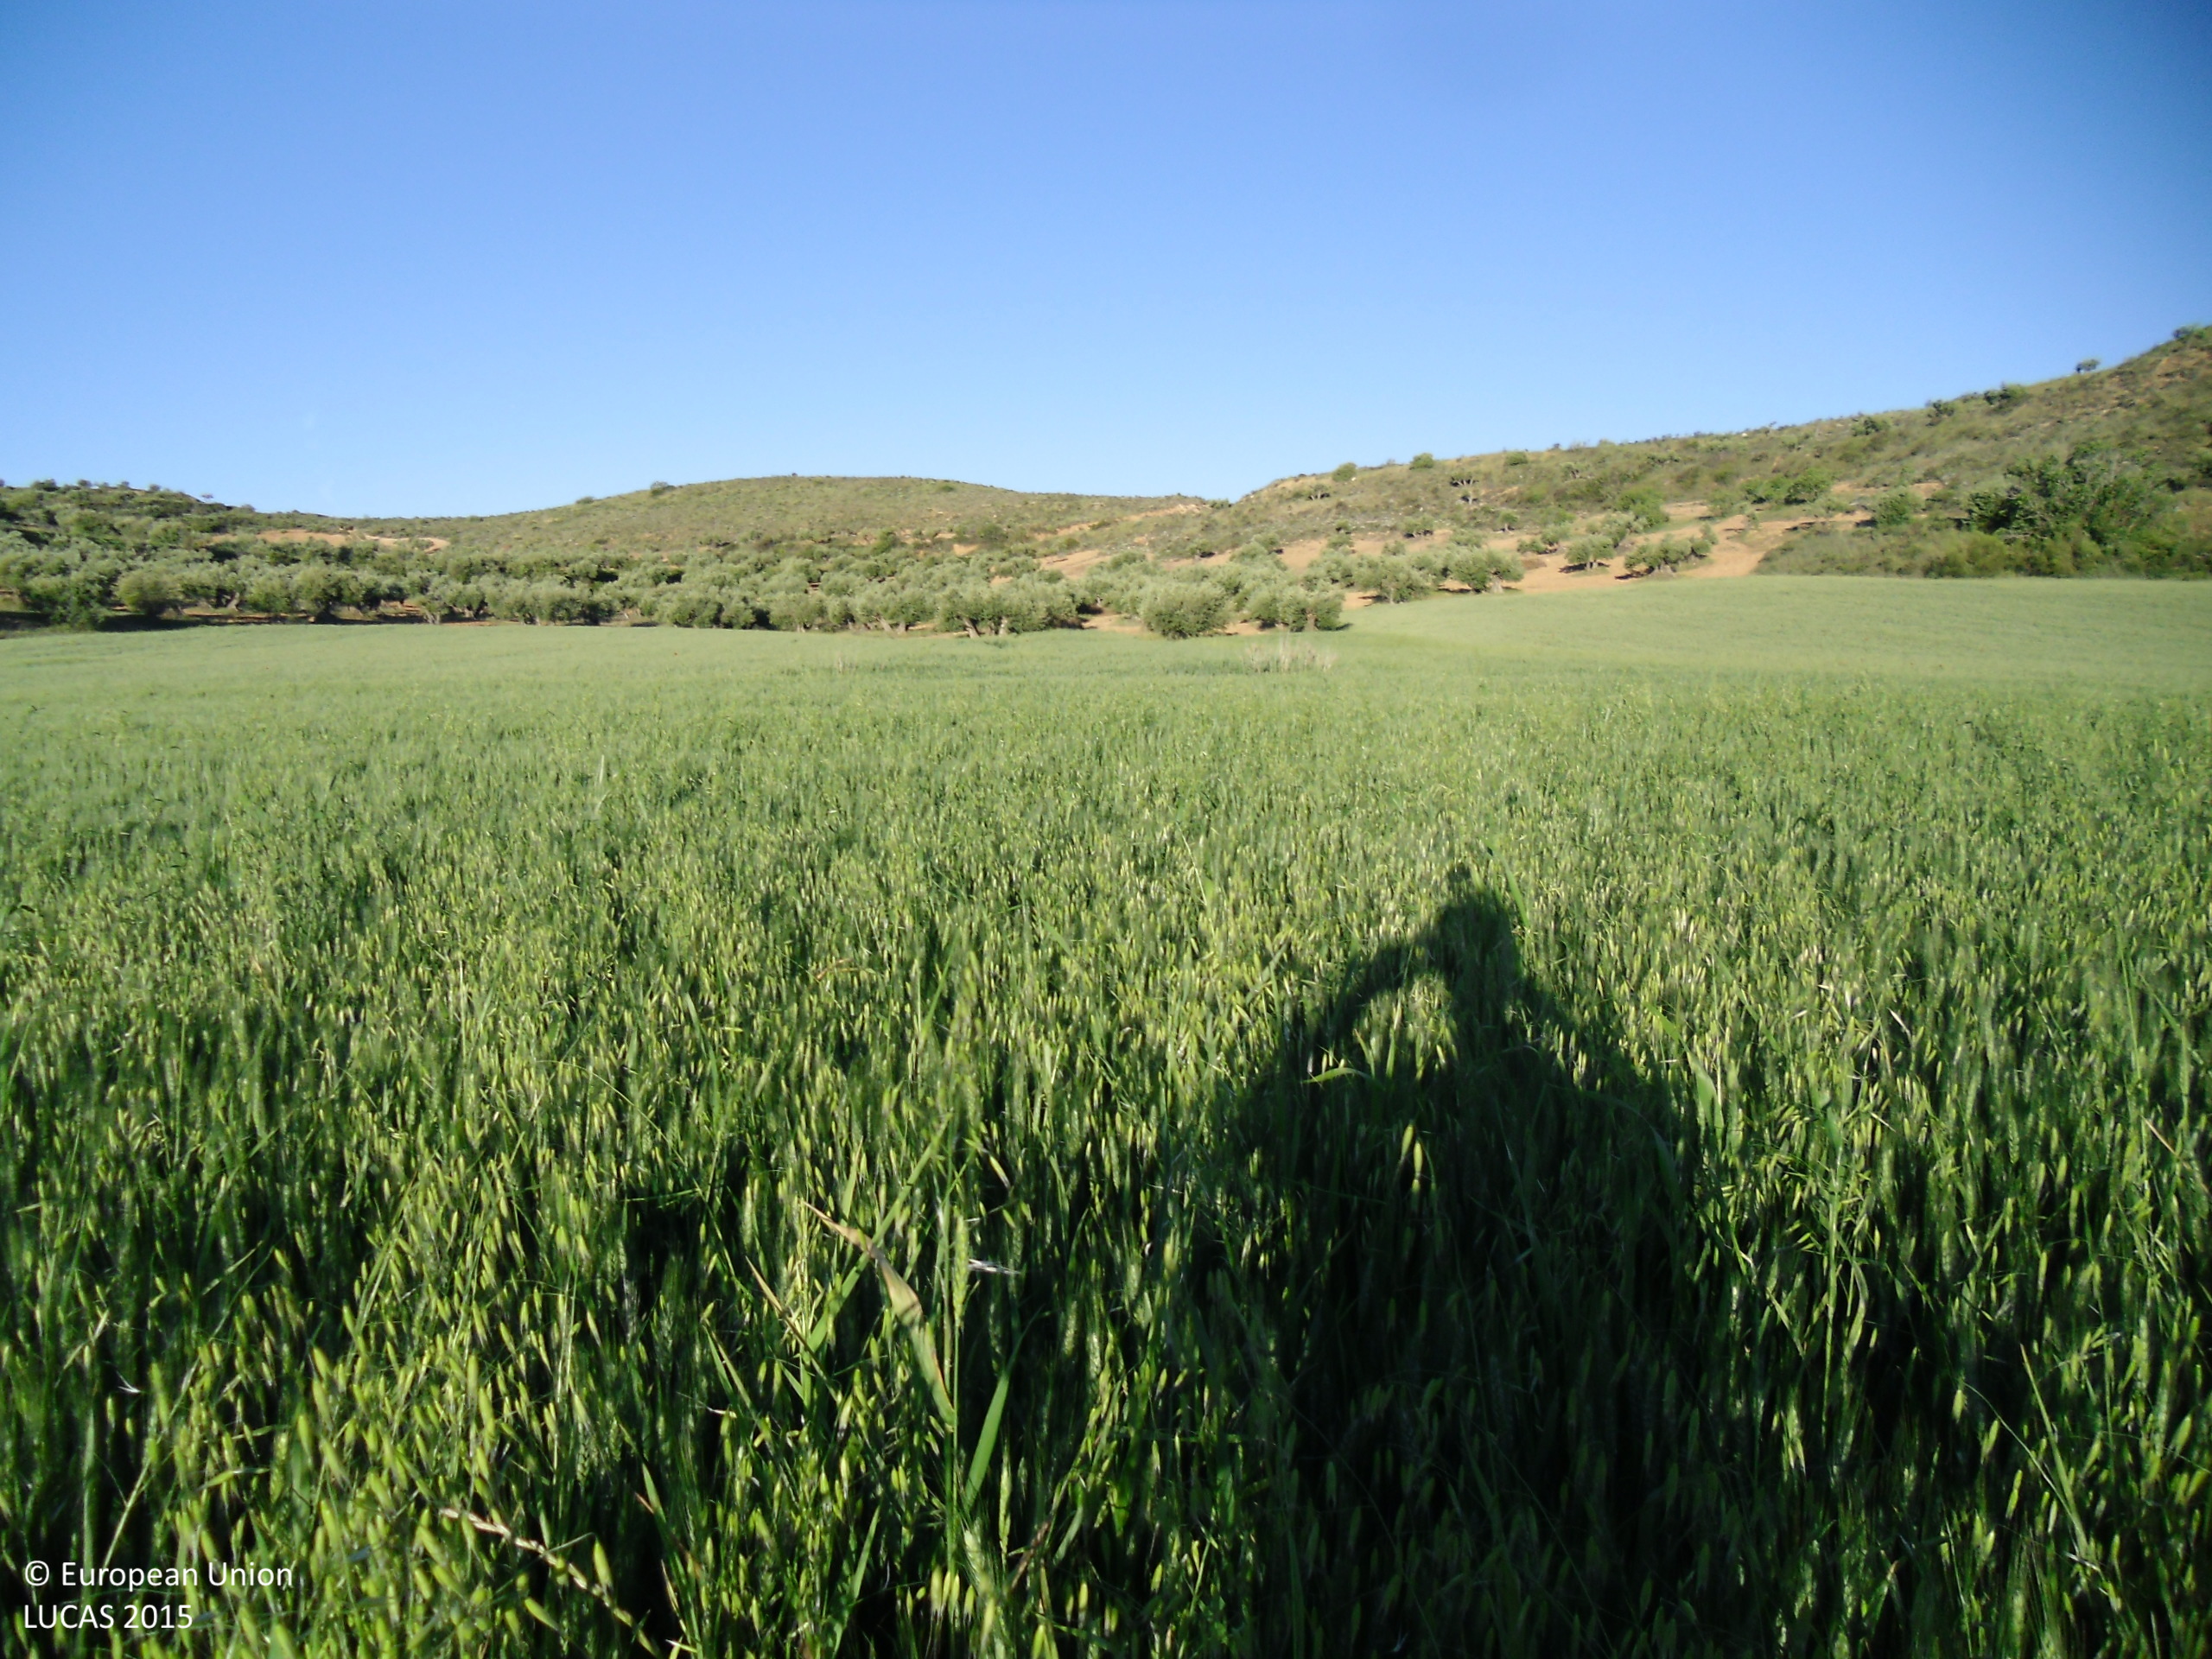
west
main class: Cropland
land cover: Triticale
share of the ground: > 75 %
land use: Agriculture (excluding fallow land and kitchen gardens)
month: May
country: ES
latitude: 40.7874
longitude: -3.0097
